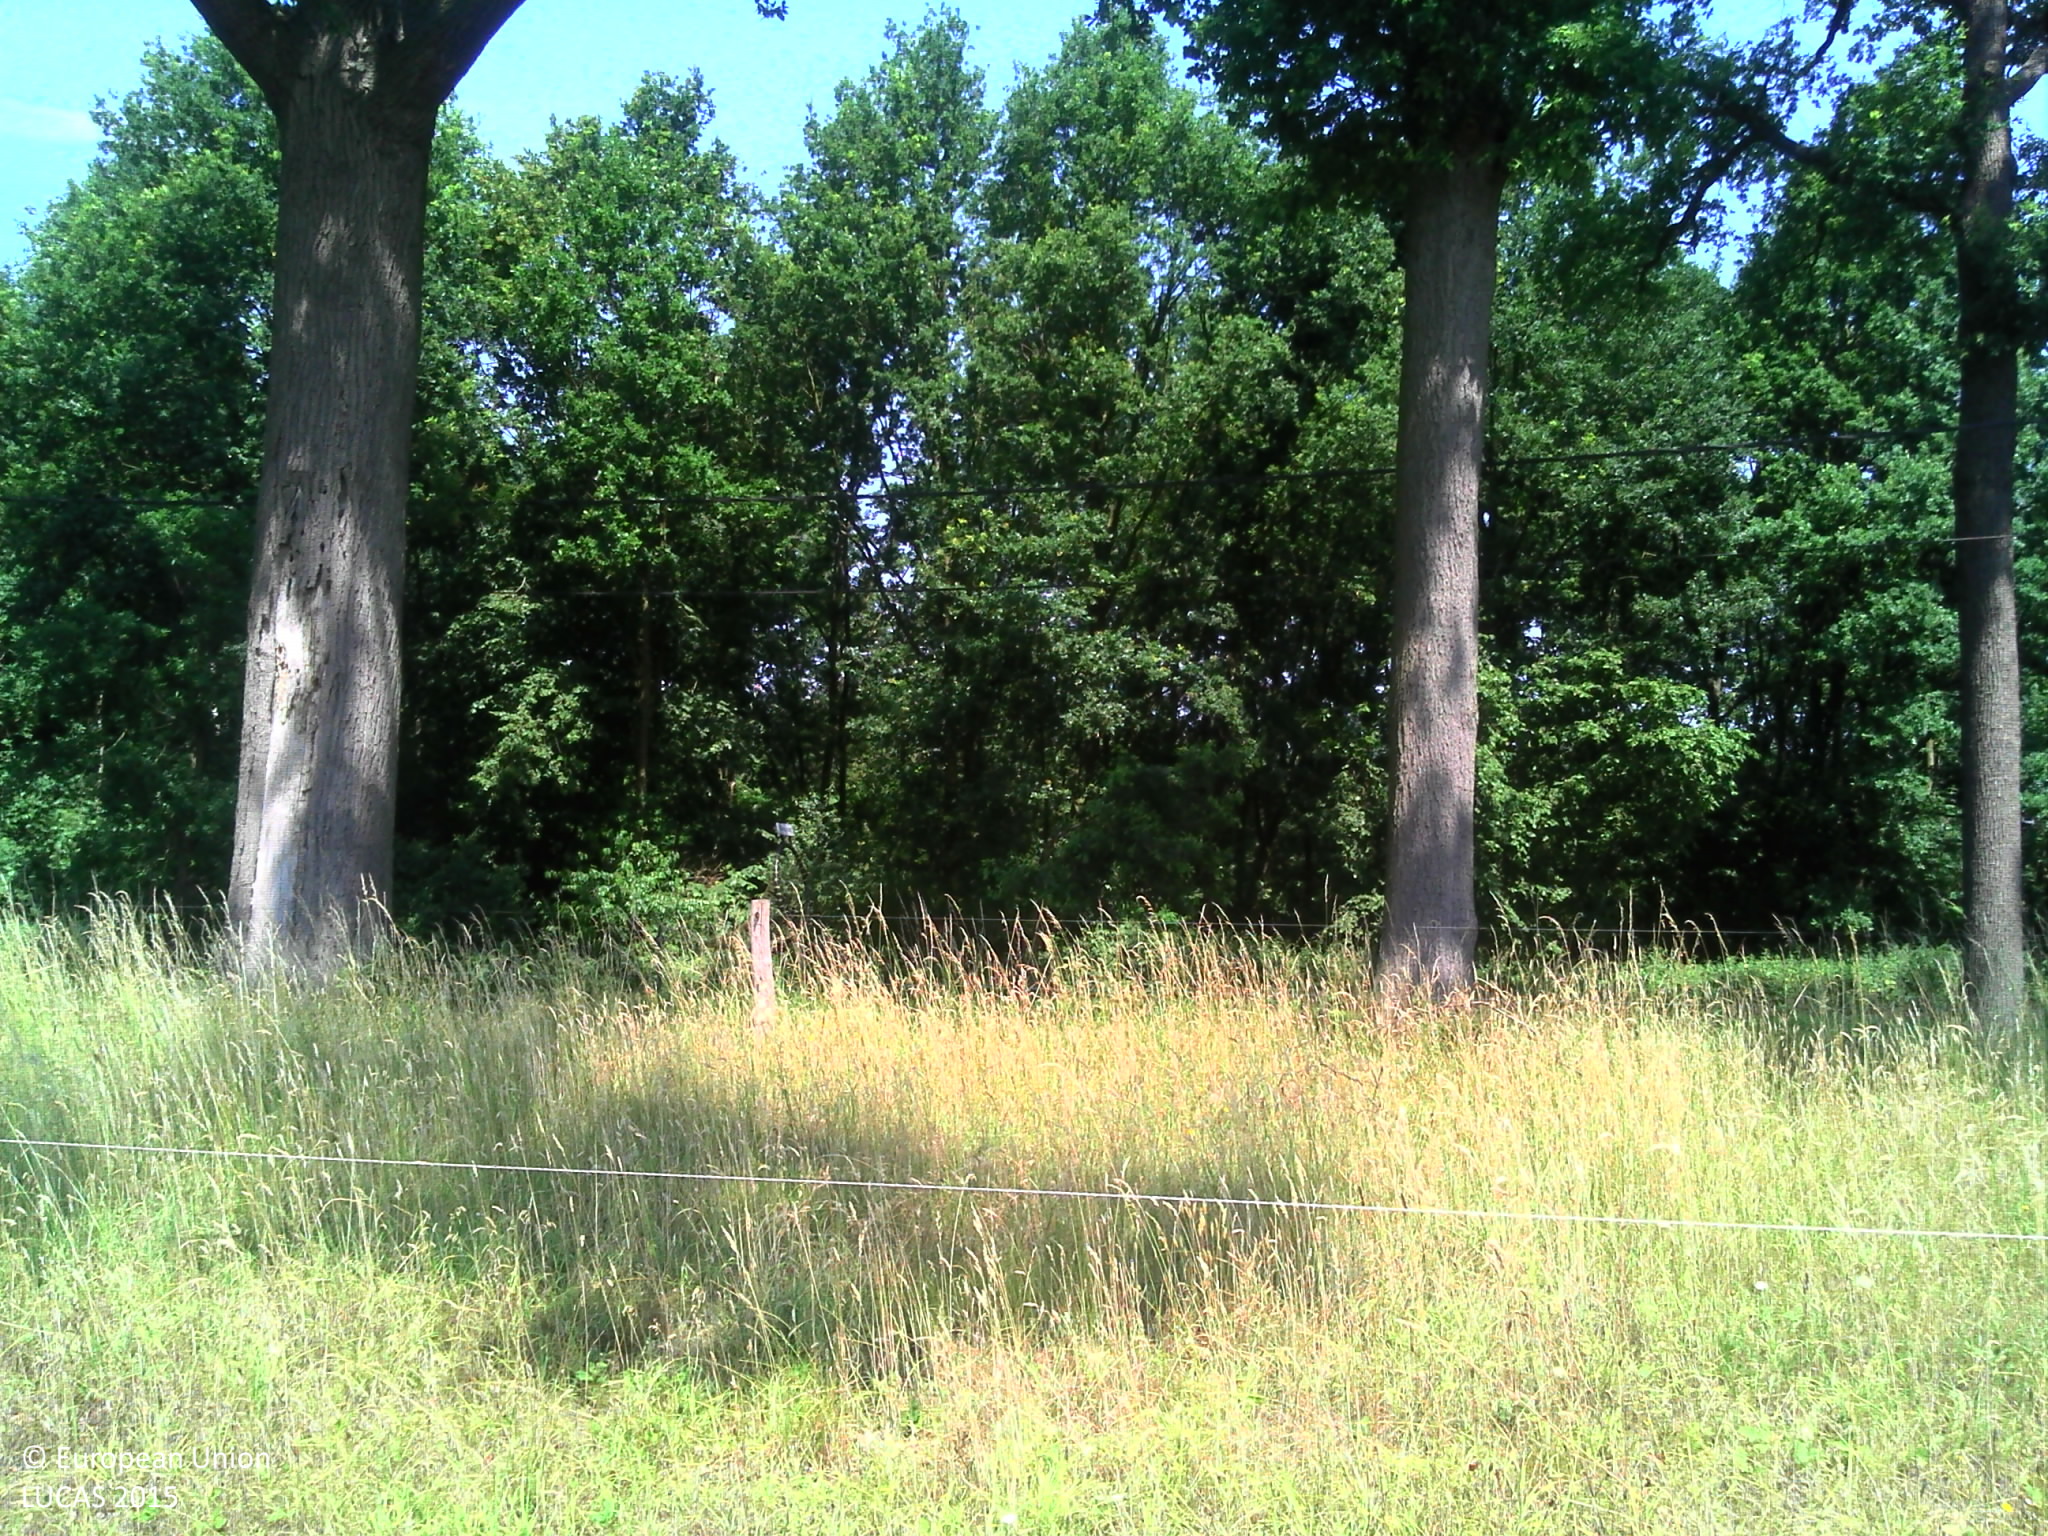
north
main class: Grassland
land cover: Grassland without tree/shrub cover
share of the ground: > 75 %
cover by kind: herbaceous plants 95 %, shrubs 5 %
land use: Agriculture (excluding fallow land and kitchen gardens)
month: July
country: BE
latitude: 50.9319
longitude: 4.8316
